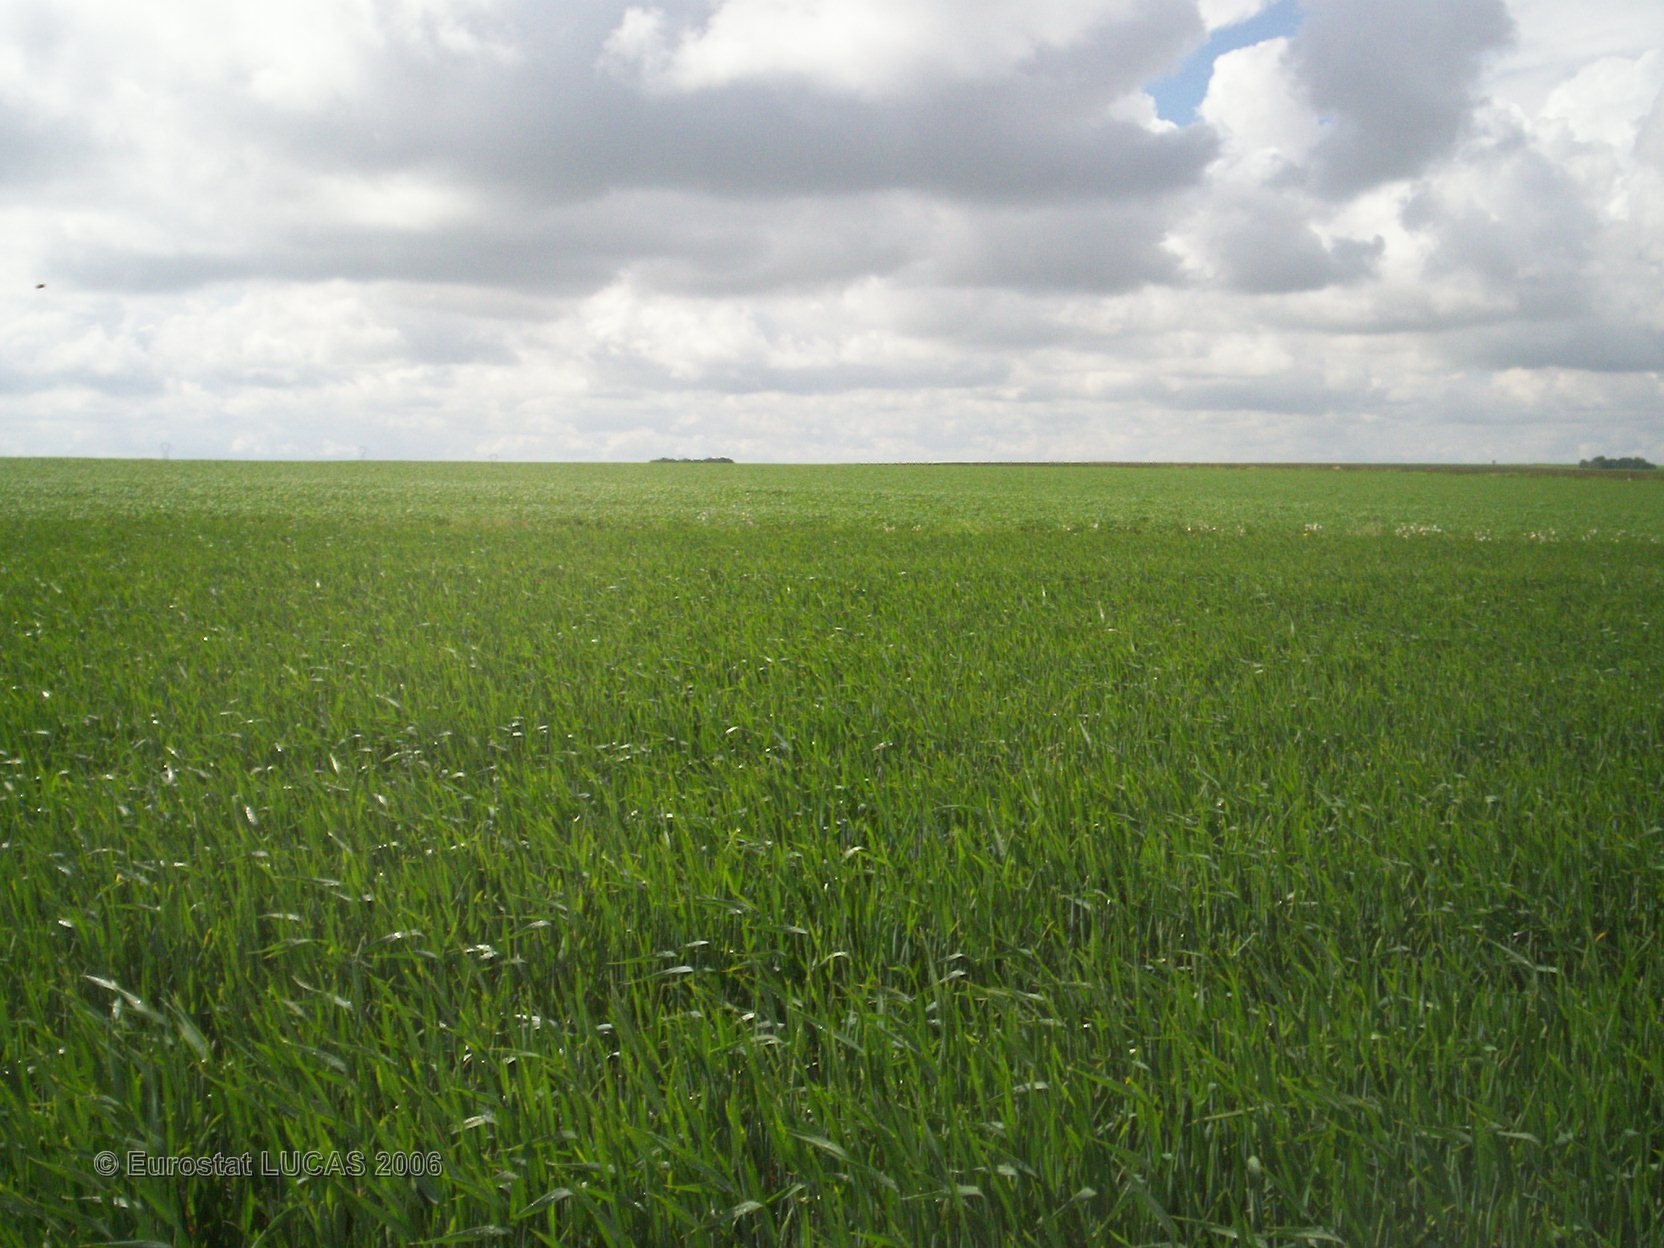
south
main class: Cropland
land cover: Common wheat
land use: Agriculture (excluding fallow land and kitchen gardens)
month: May
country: FR
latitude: 49.3791
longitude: 4.3900
